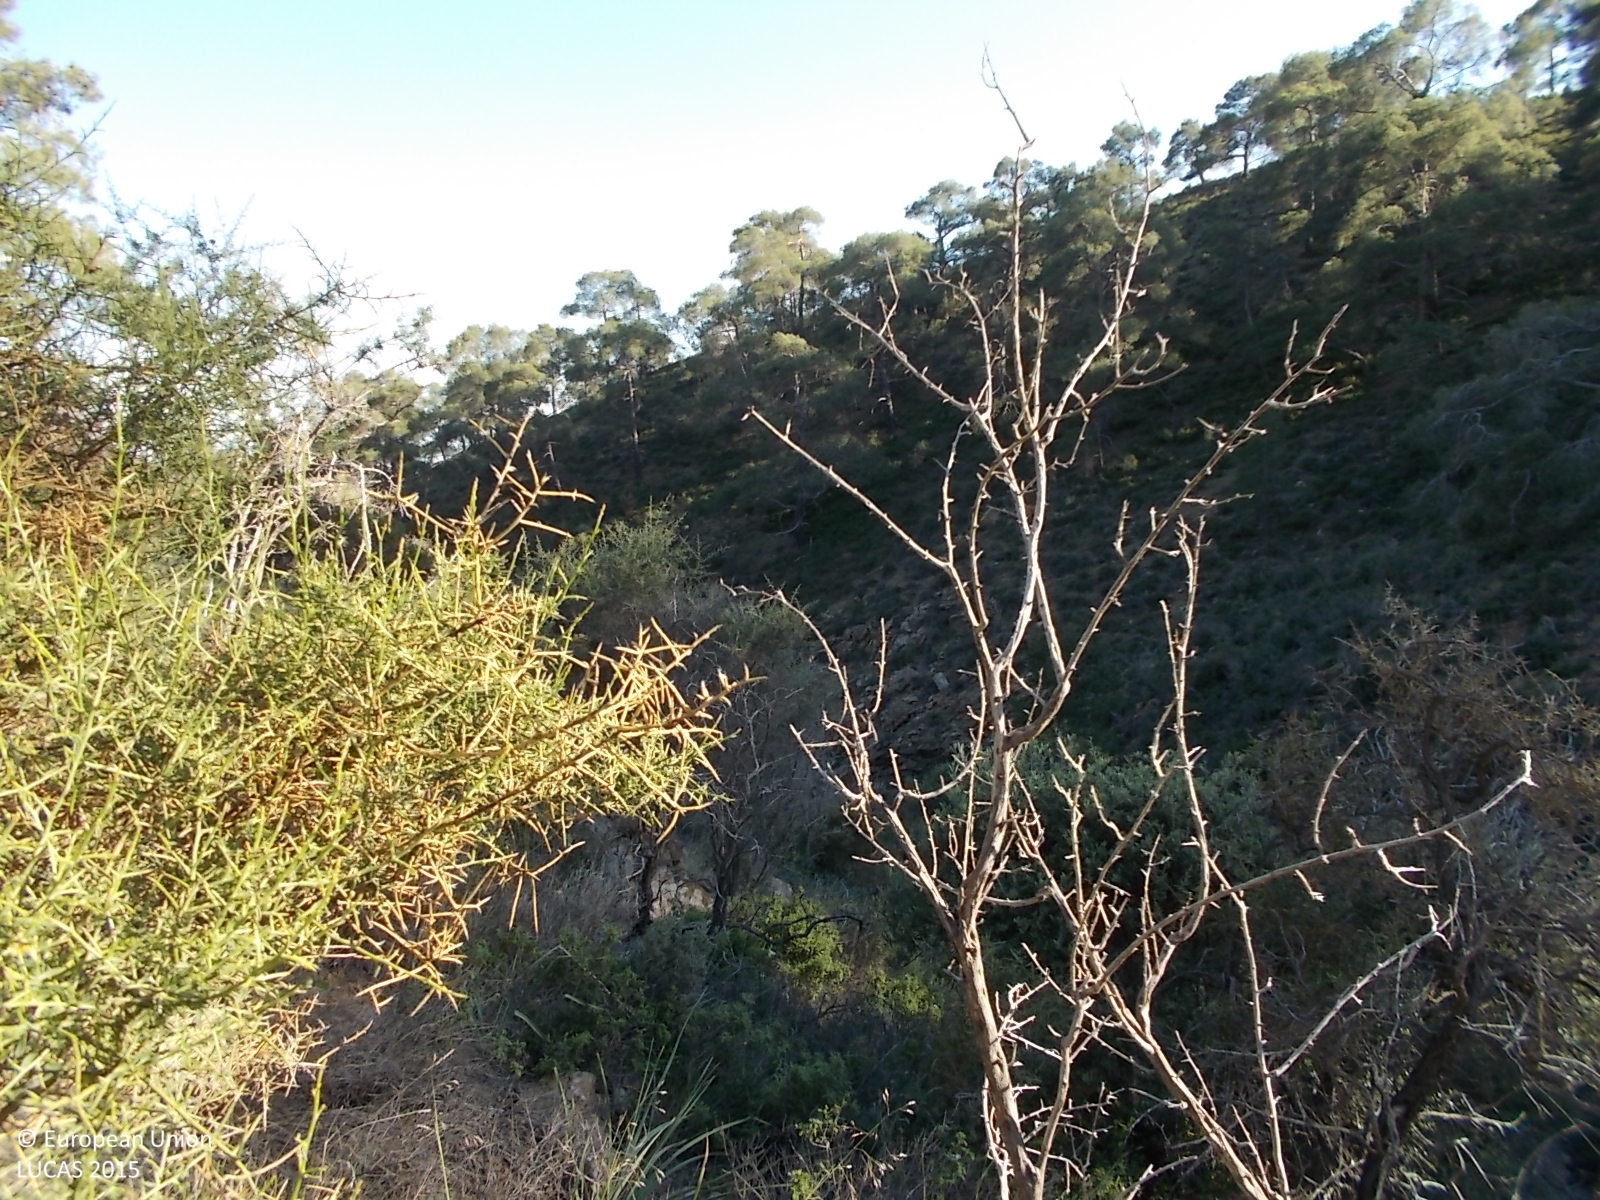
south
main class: Shrubland
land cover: Shrubland without tree cover
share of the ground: > 75 %
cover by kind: shrubs 95 %, herbaceous plants 5 %
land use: Semi-natural and natural areas not in use
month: April
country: CY
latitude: 34.7793
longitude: 33.1302
